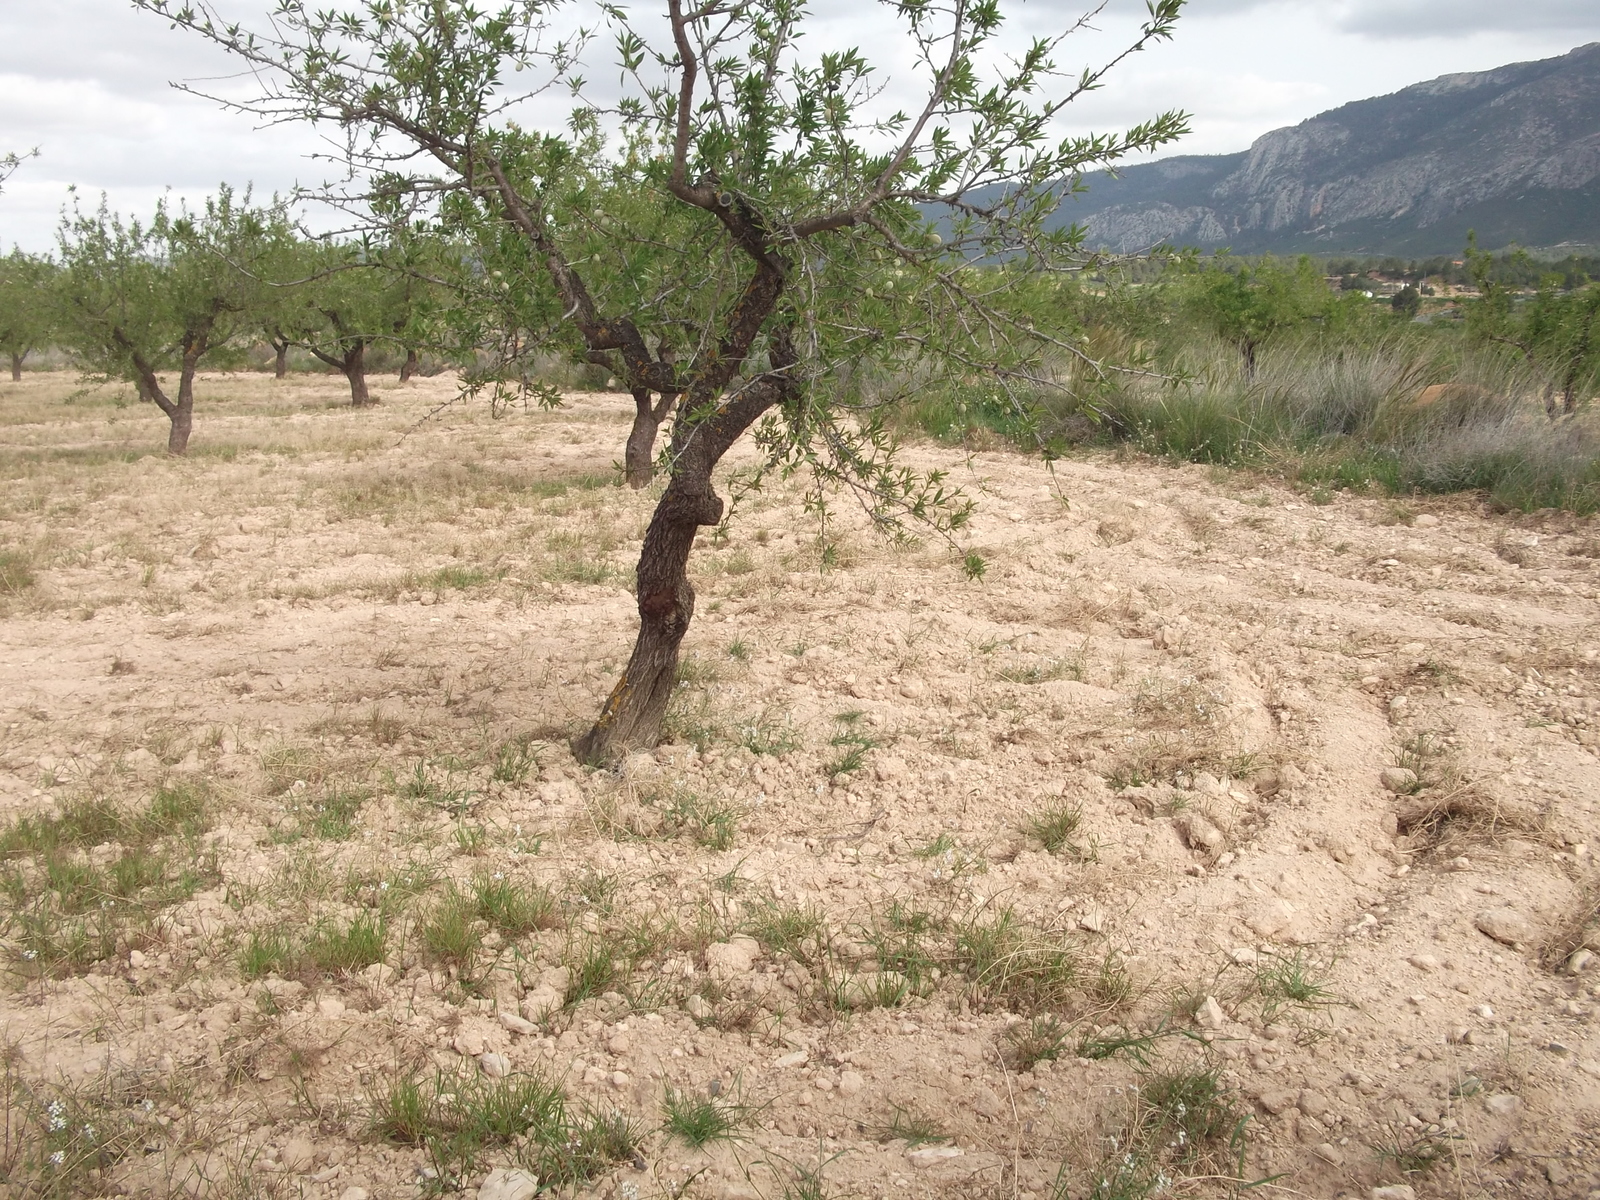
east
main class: Cropland
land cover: Nuts trees
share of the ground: < 10 %
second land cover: Spontaneously vegetated surfaces
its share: > 75 %
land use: Agriculture (excluding fallow land and kitchen gardens)
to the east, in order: Nuts trees; Spontaneously vegetated surfaces; Dry stone walls; Nuts trees
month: April
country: ES
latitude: 37.9522
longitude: -1.5824
